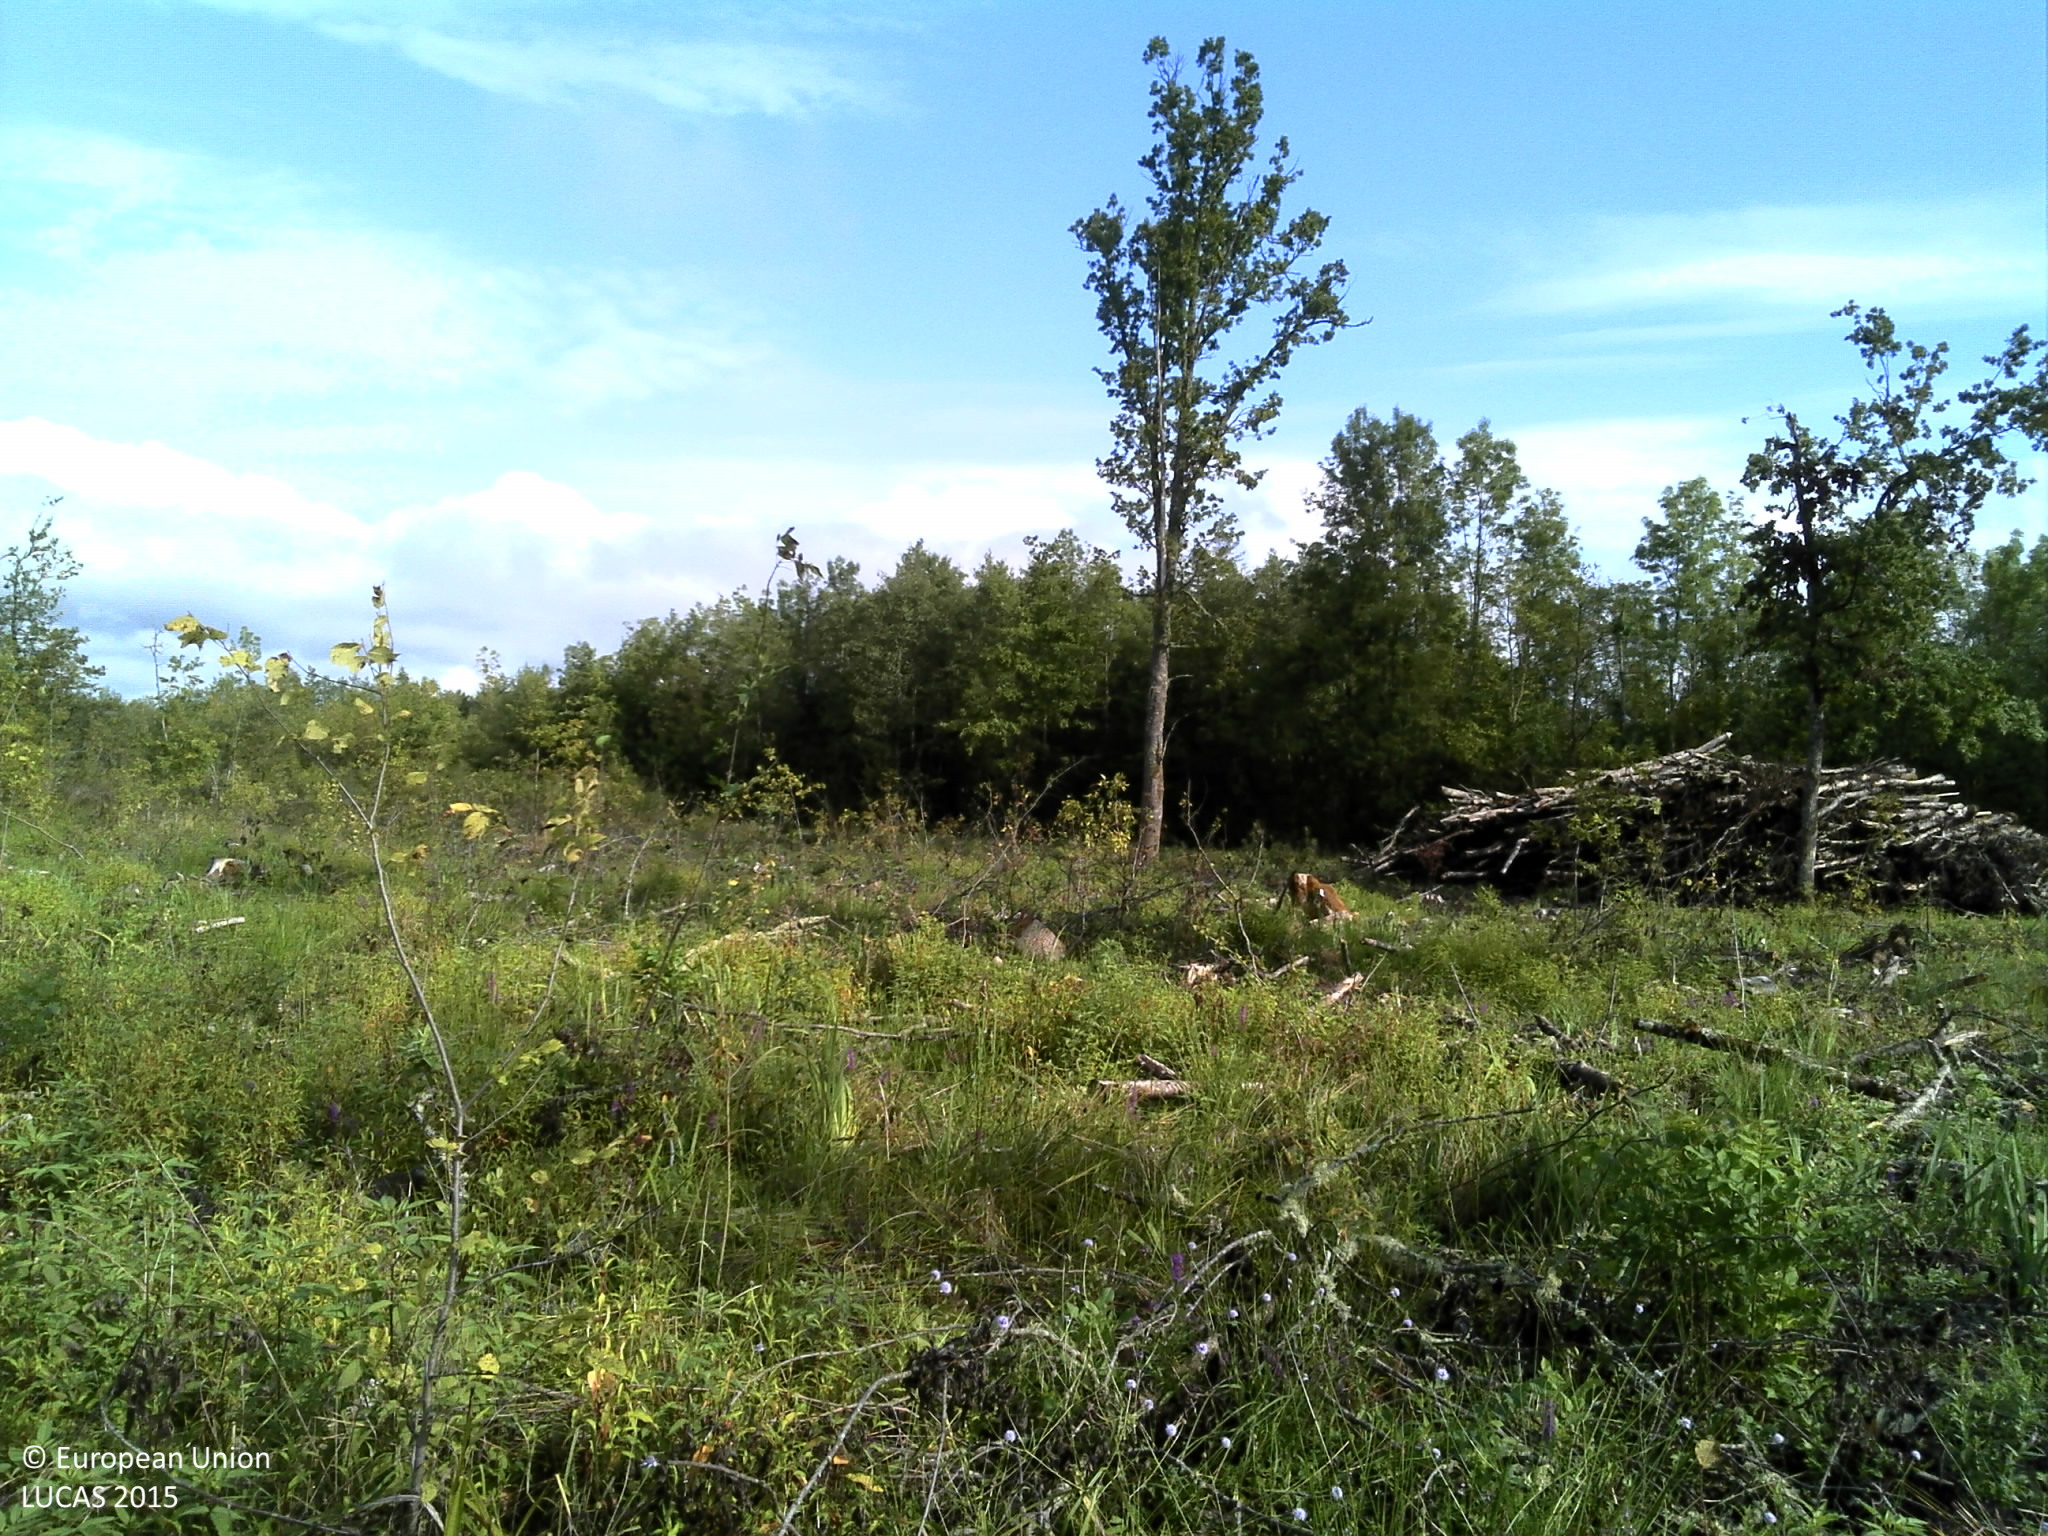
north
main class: Grassland
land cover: Spontaneously vegetated surfaces
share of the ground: > 75 %
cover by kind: herbaceous plants 100 %
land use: Forestry
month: August
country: HR
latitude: 45.5686
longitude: 15.6729
